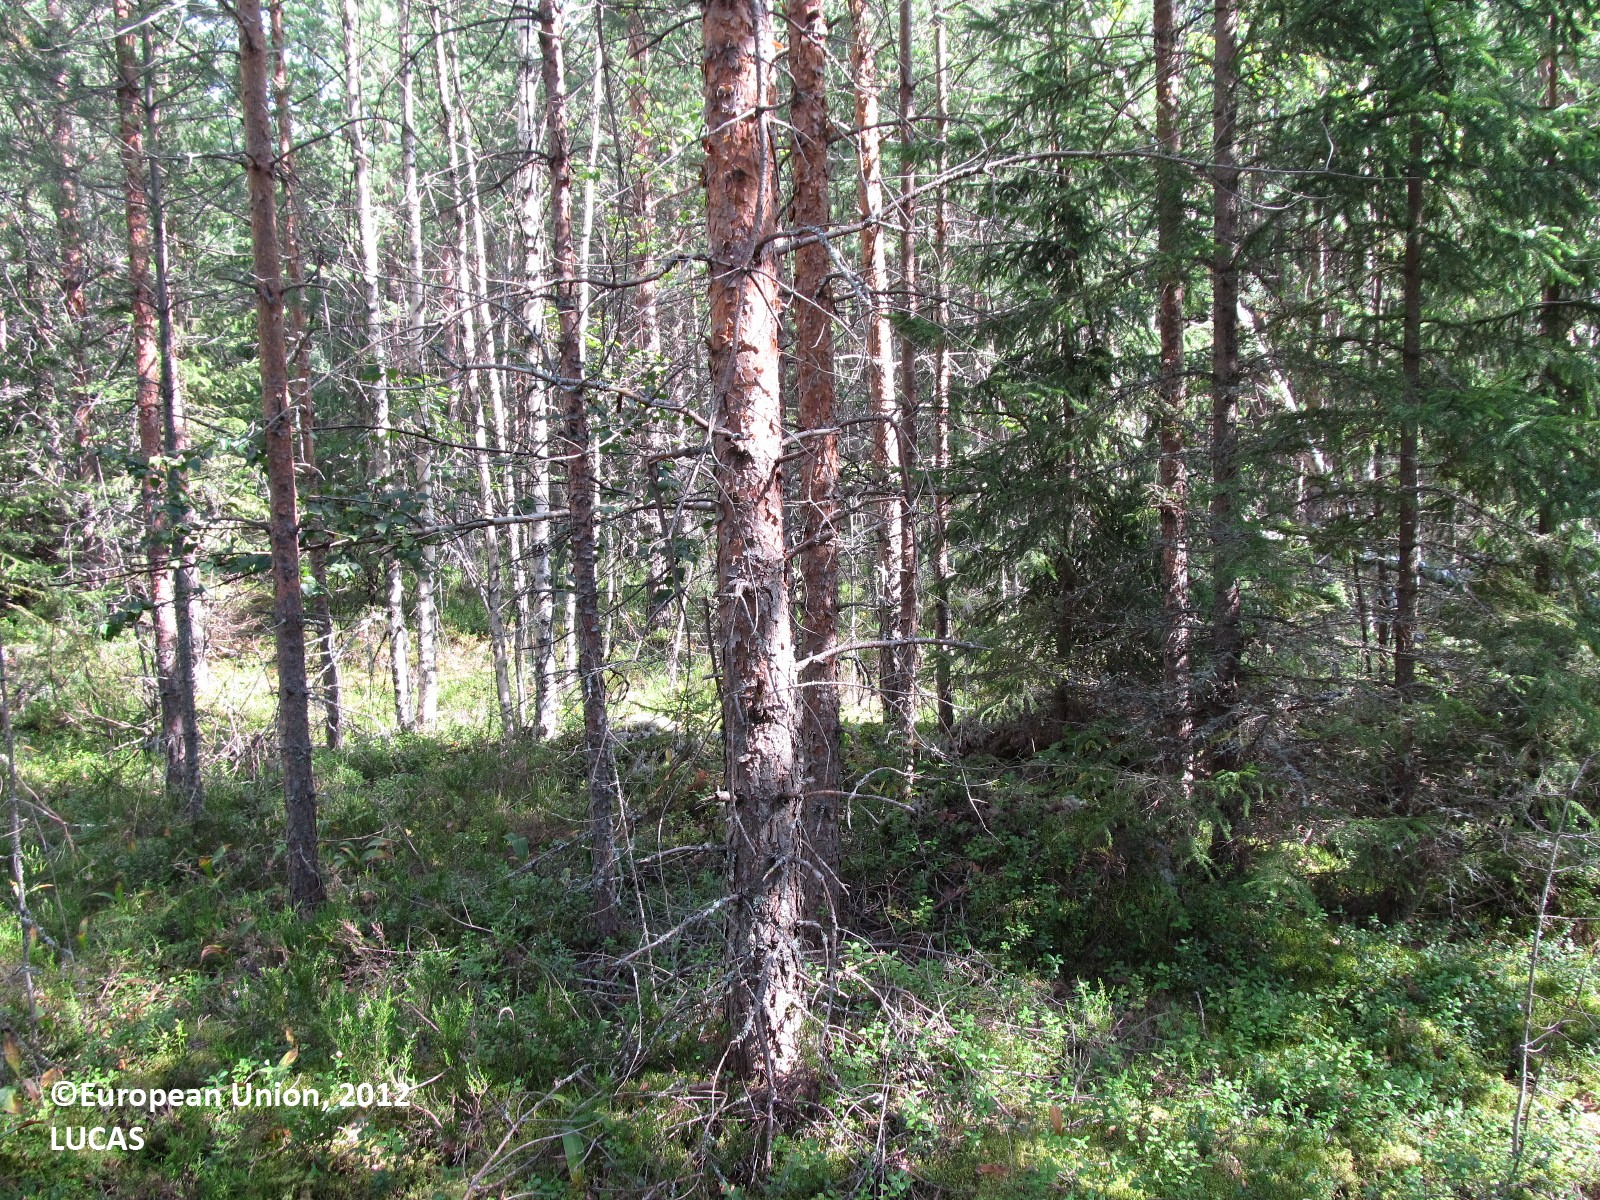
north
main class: Woodland
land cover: Other coniferous woodland
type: boreal forest
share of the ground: 50 - 75 %
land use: Forestry
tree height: > 5 m
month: August
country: FI
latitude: 62.3929
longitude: 27.6399
